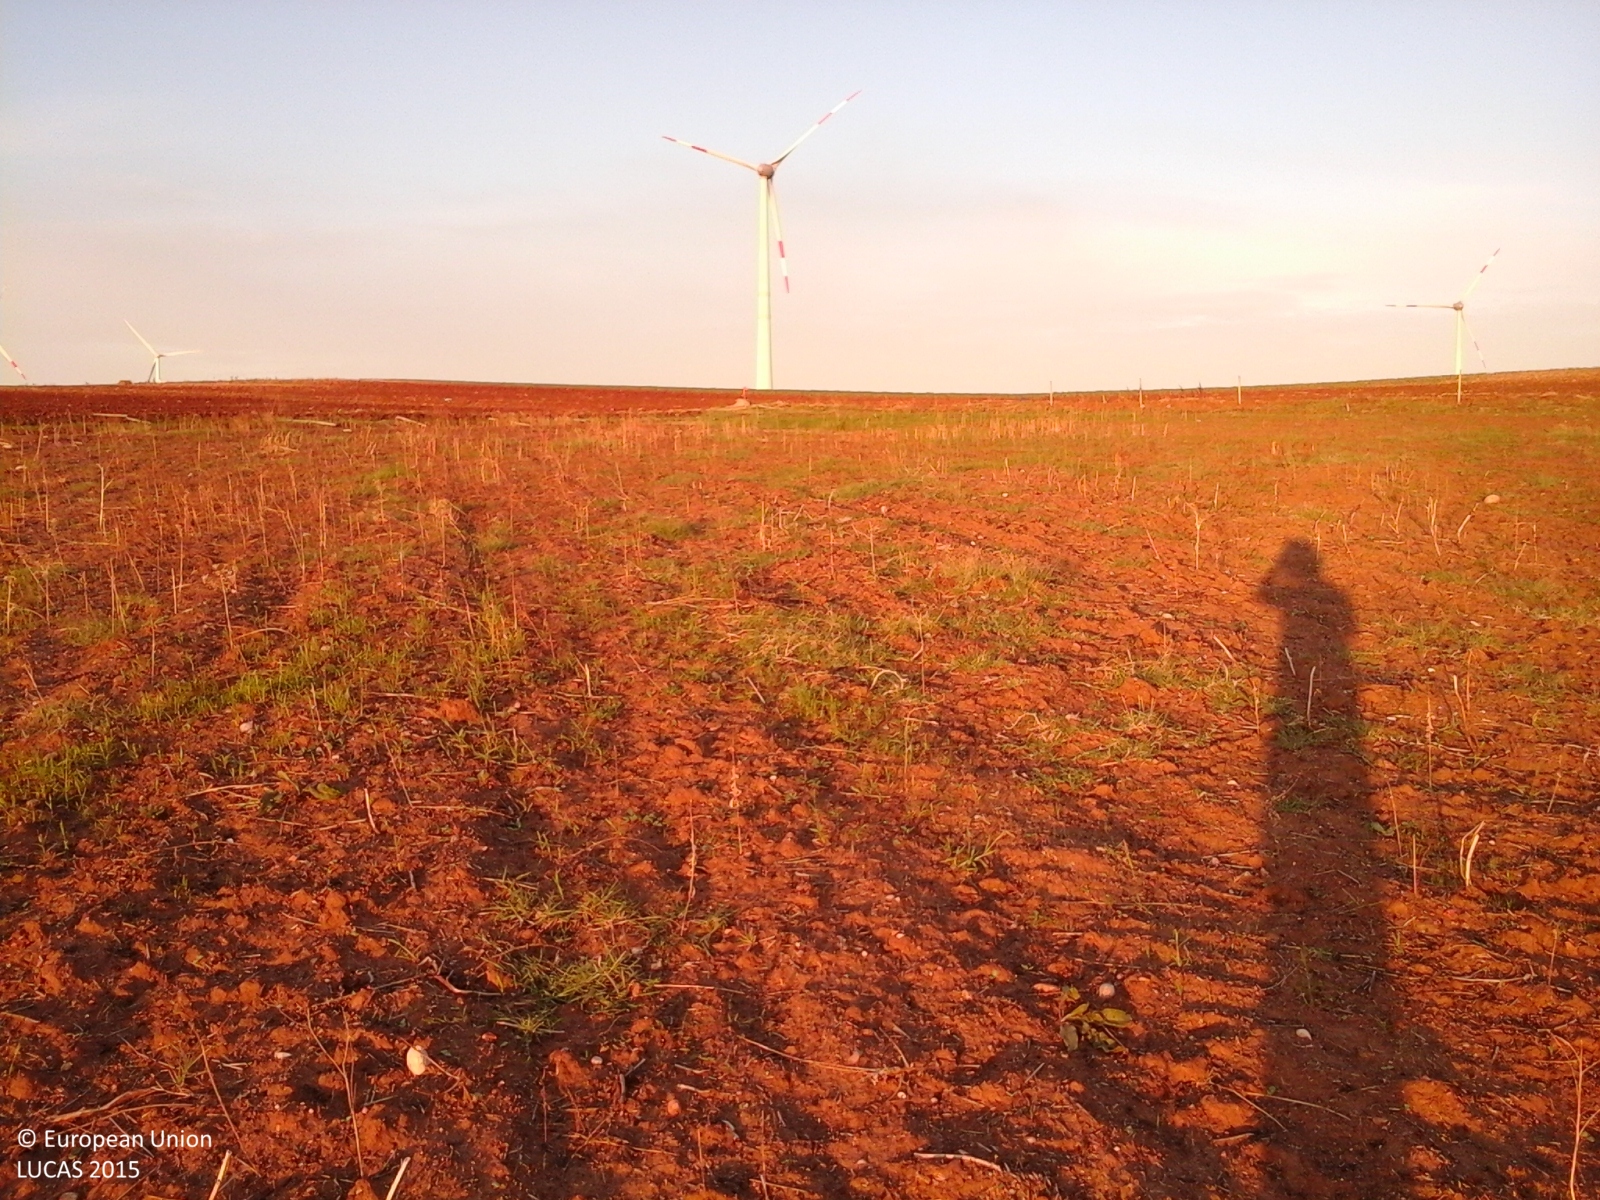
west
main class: Cropland
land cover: Dry pulses
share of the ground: > 75 %
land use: Agriculture (excluding fallow land and kitchen gardens)
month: October
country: IT
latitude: 41.8856
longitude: 15.2264
